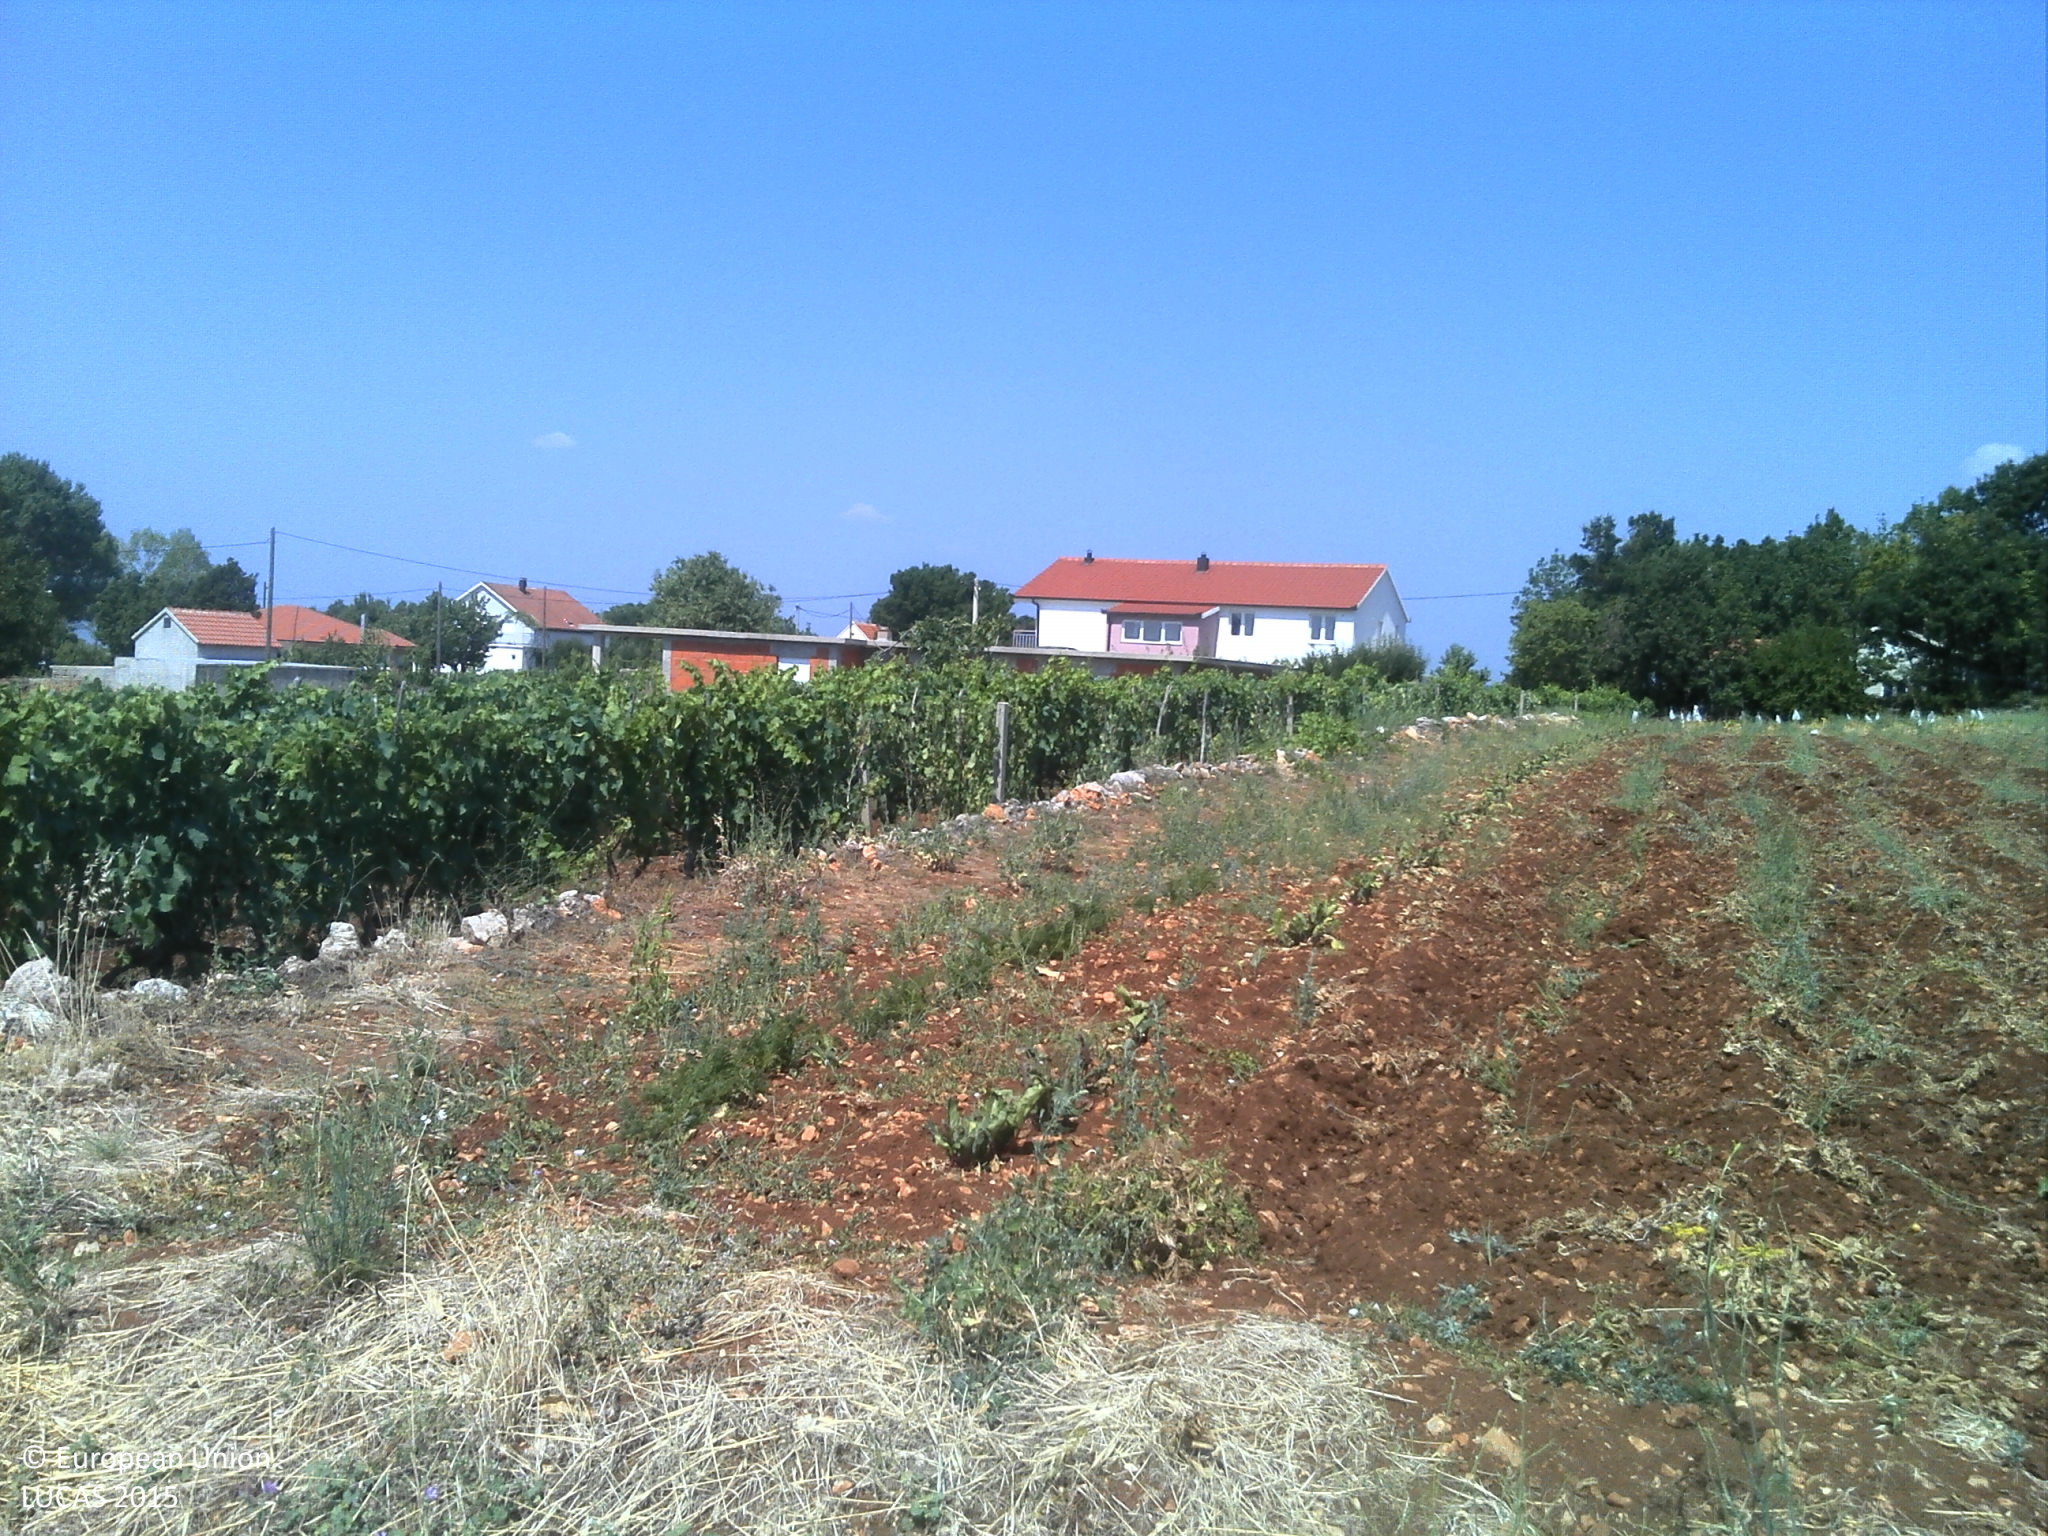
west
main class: Cropland
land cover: Vineyards
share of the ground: > 75 %
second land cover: Other bare soil
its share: > 75 %
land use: Agriculture (excluding fallow land and kitchen gardens)
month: July
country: HR
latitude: 43.4435
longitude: 17.2697
